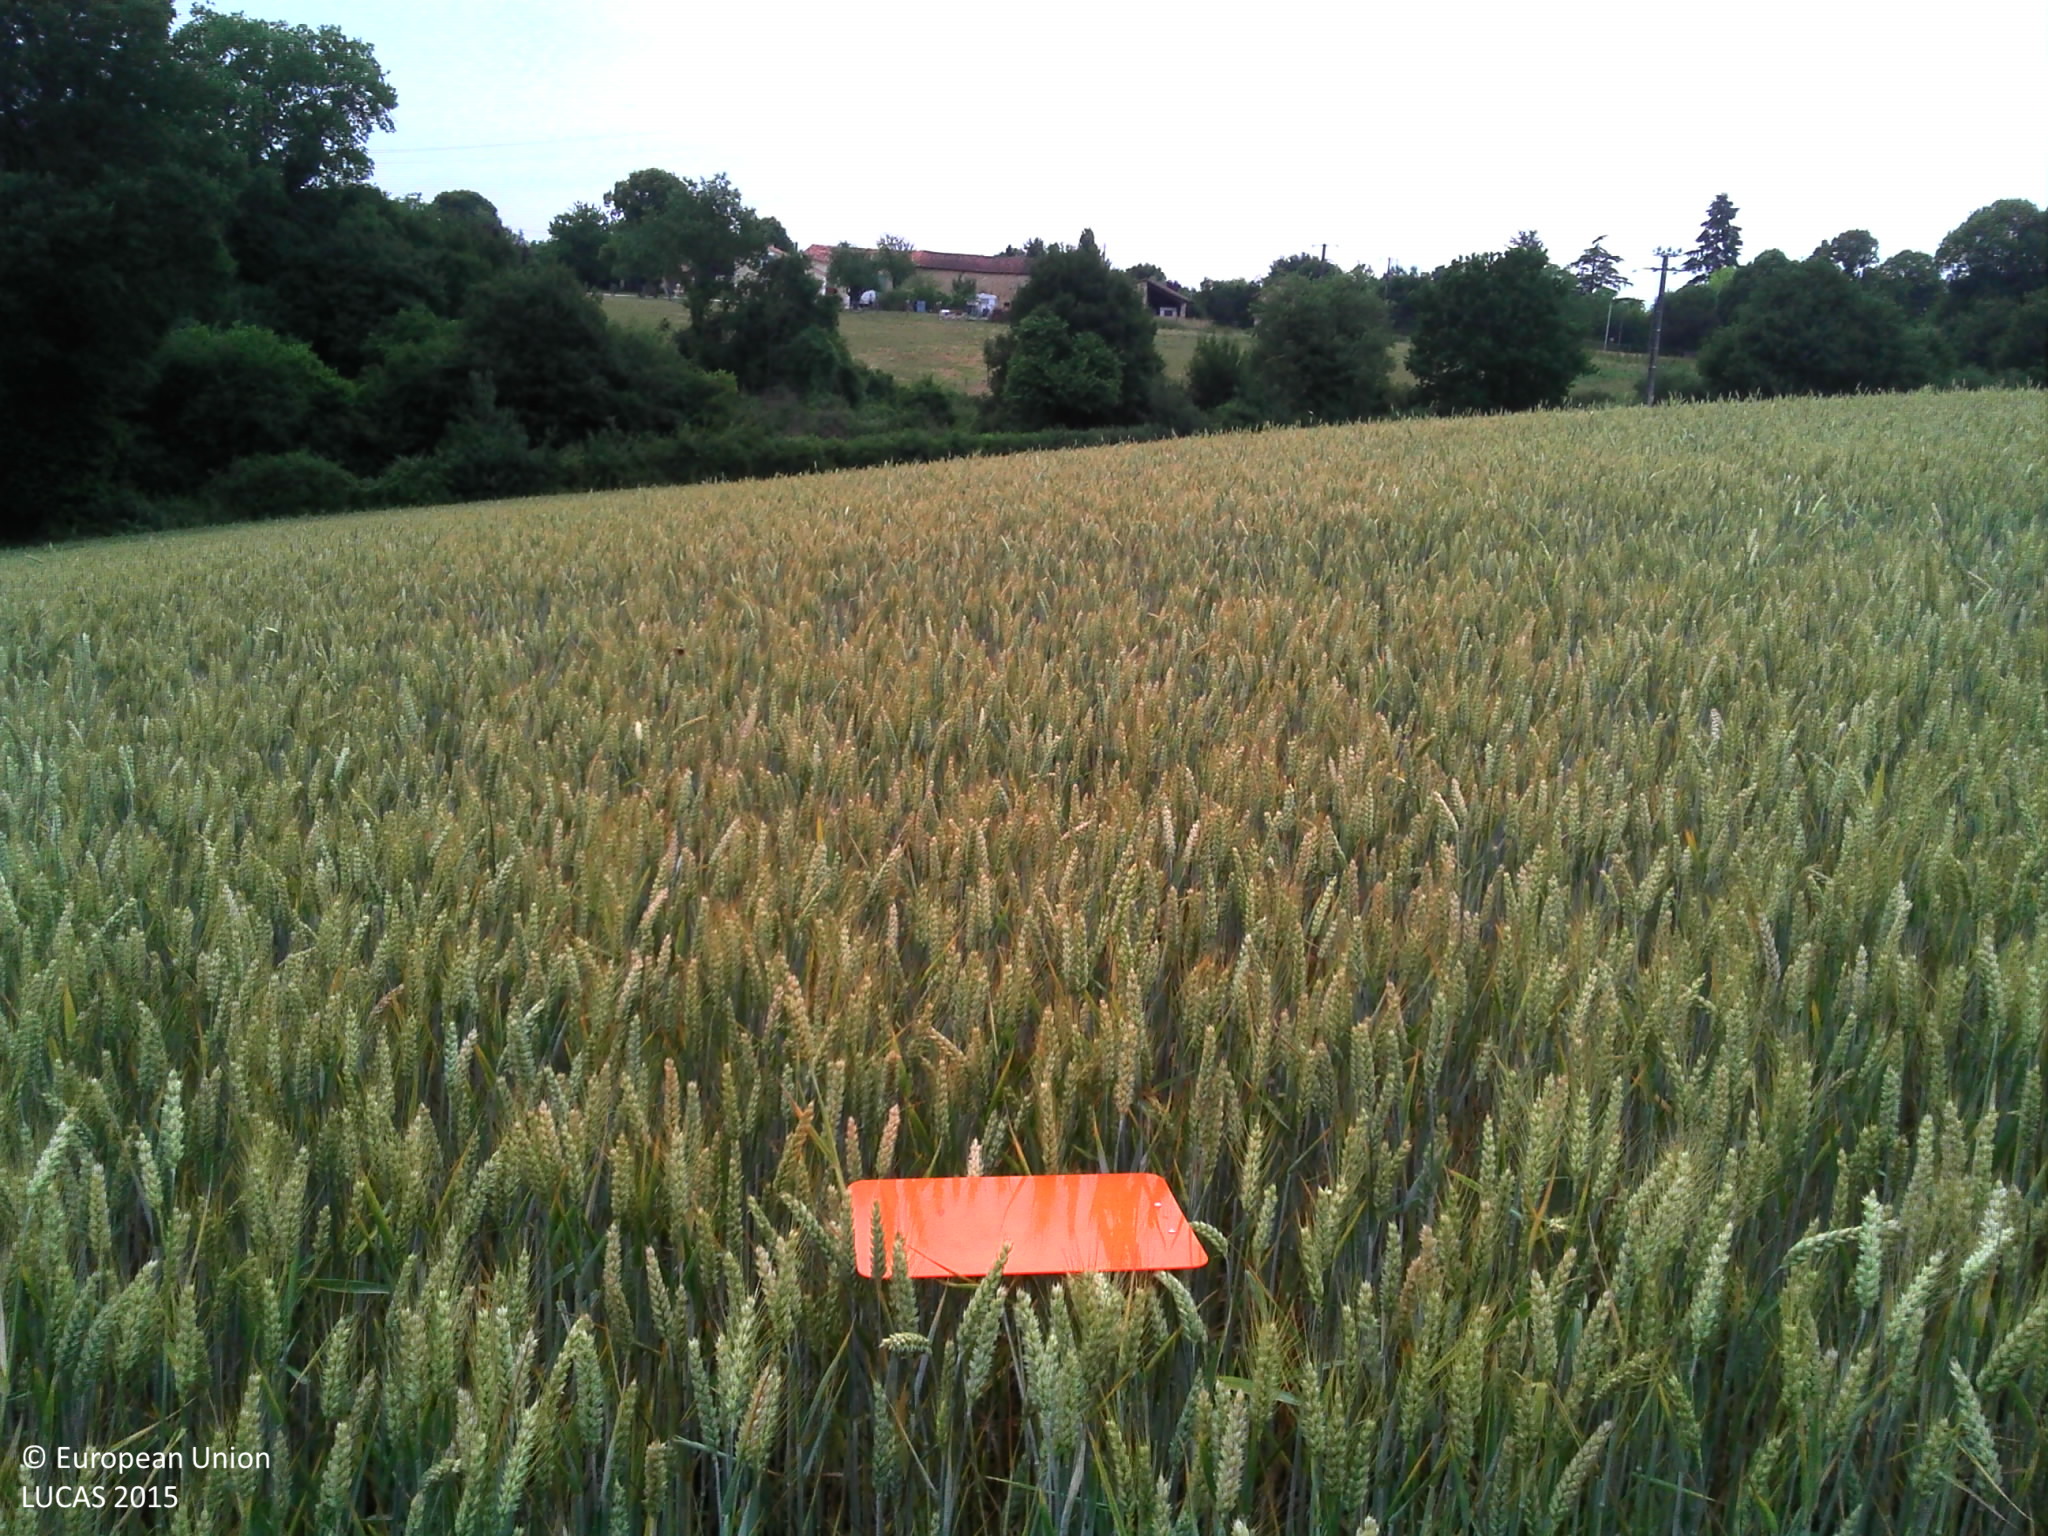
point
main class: Cropland
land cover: Common wheat
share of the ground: > 75 %
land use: Agriculture (excluding fallow land and kitchen gardens)
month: June
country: FR
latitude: 45.9010
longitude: 0.4076
